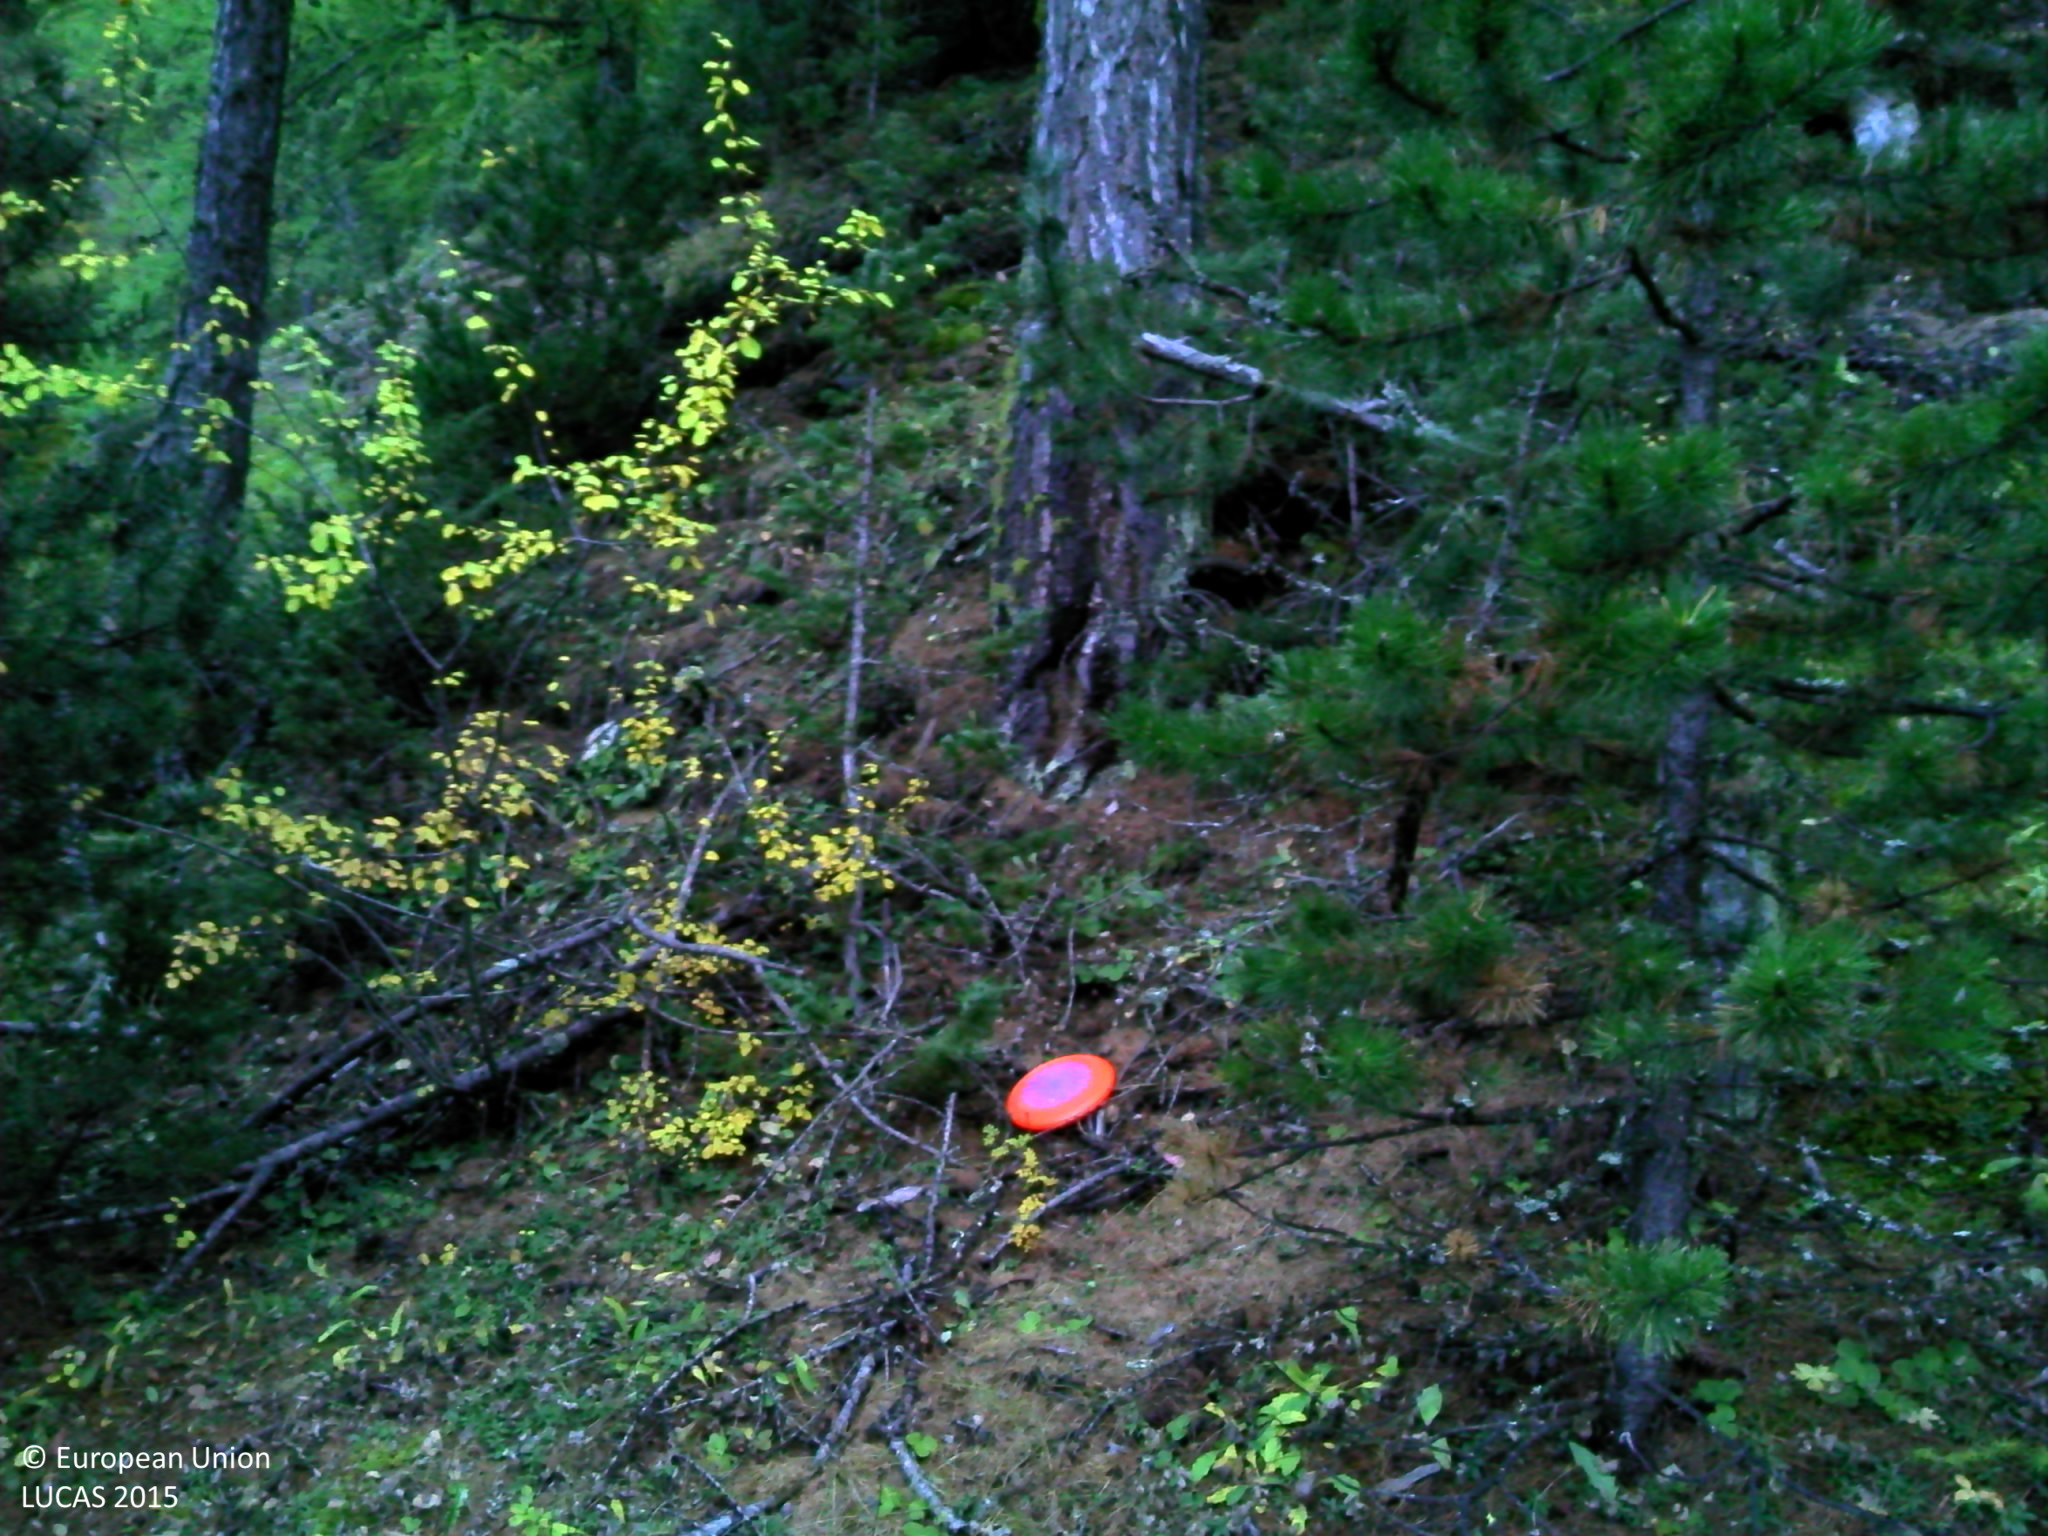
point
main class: Woodland
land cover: Pine dominated coniferous woodland
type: alpine coniferous forest
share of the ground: > 75 %
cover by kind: coniferous forest trees 70 %, shrubs 10 %, herbaceous plants 10 %, unconsolidated bare surface 10 %
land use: Forestry
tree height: > 5 m
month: October
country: FR
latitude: 44.7512
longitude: 6.7594
